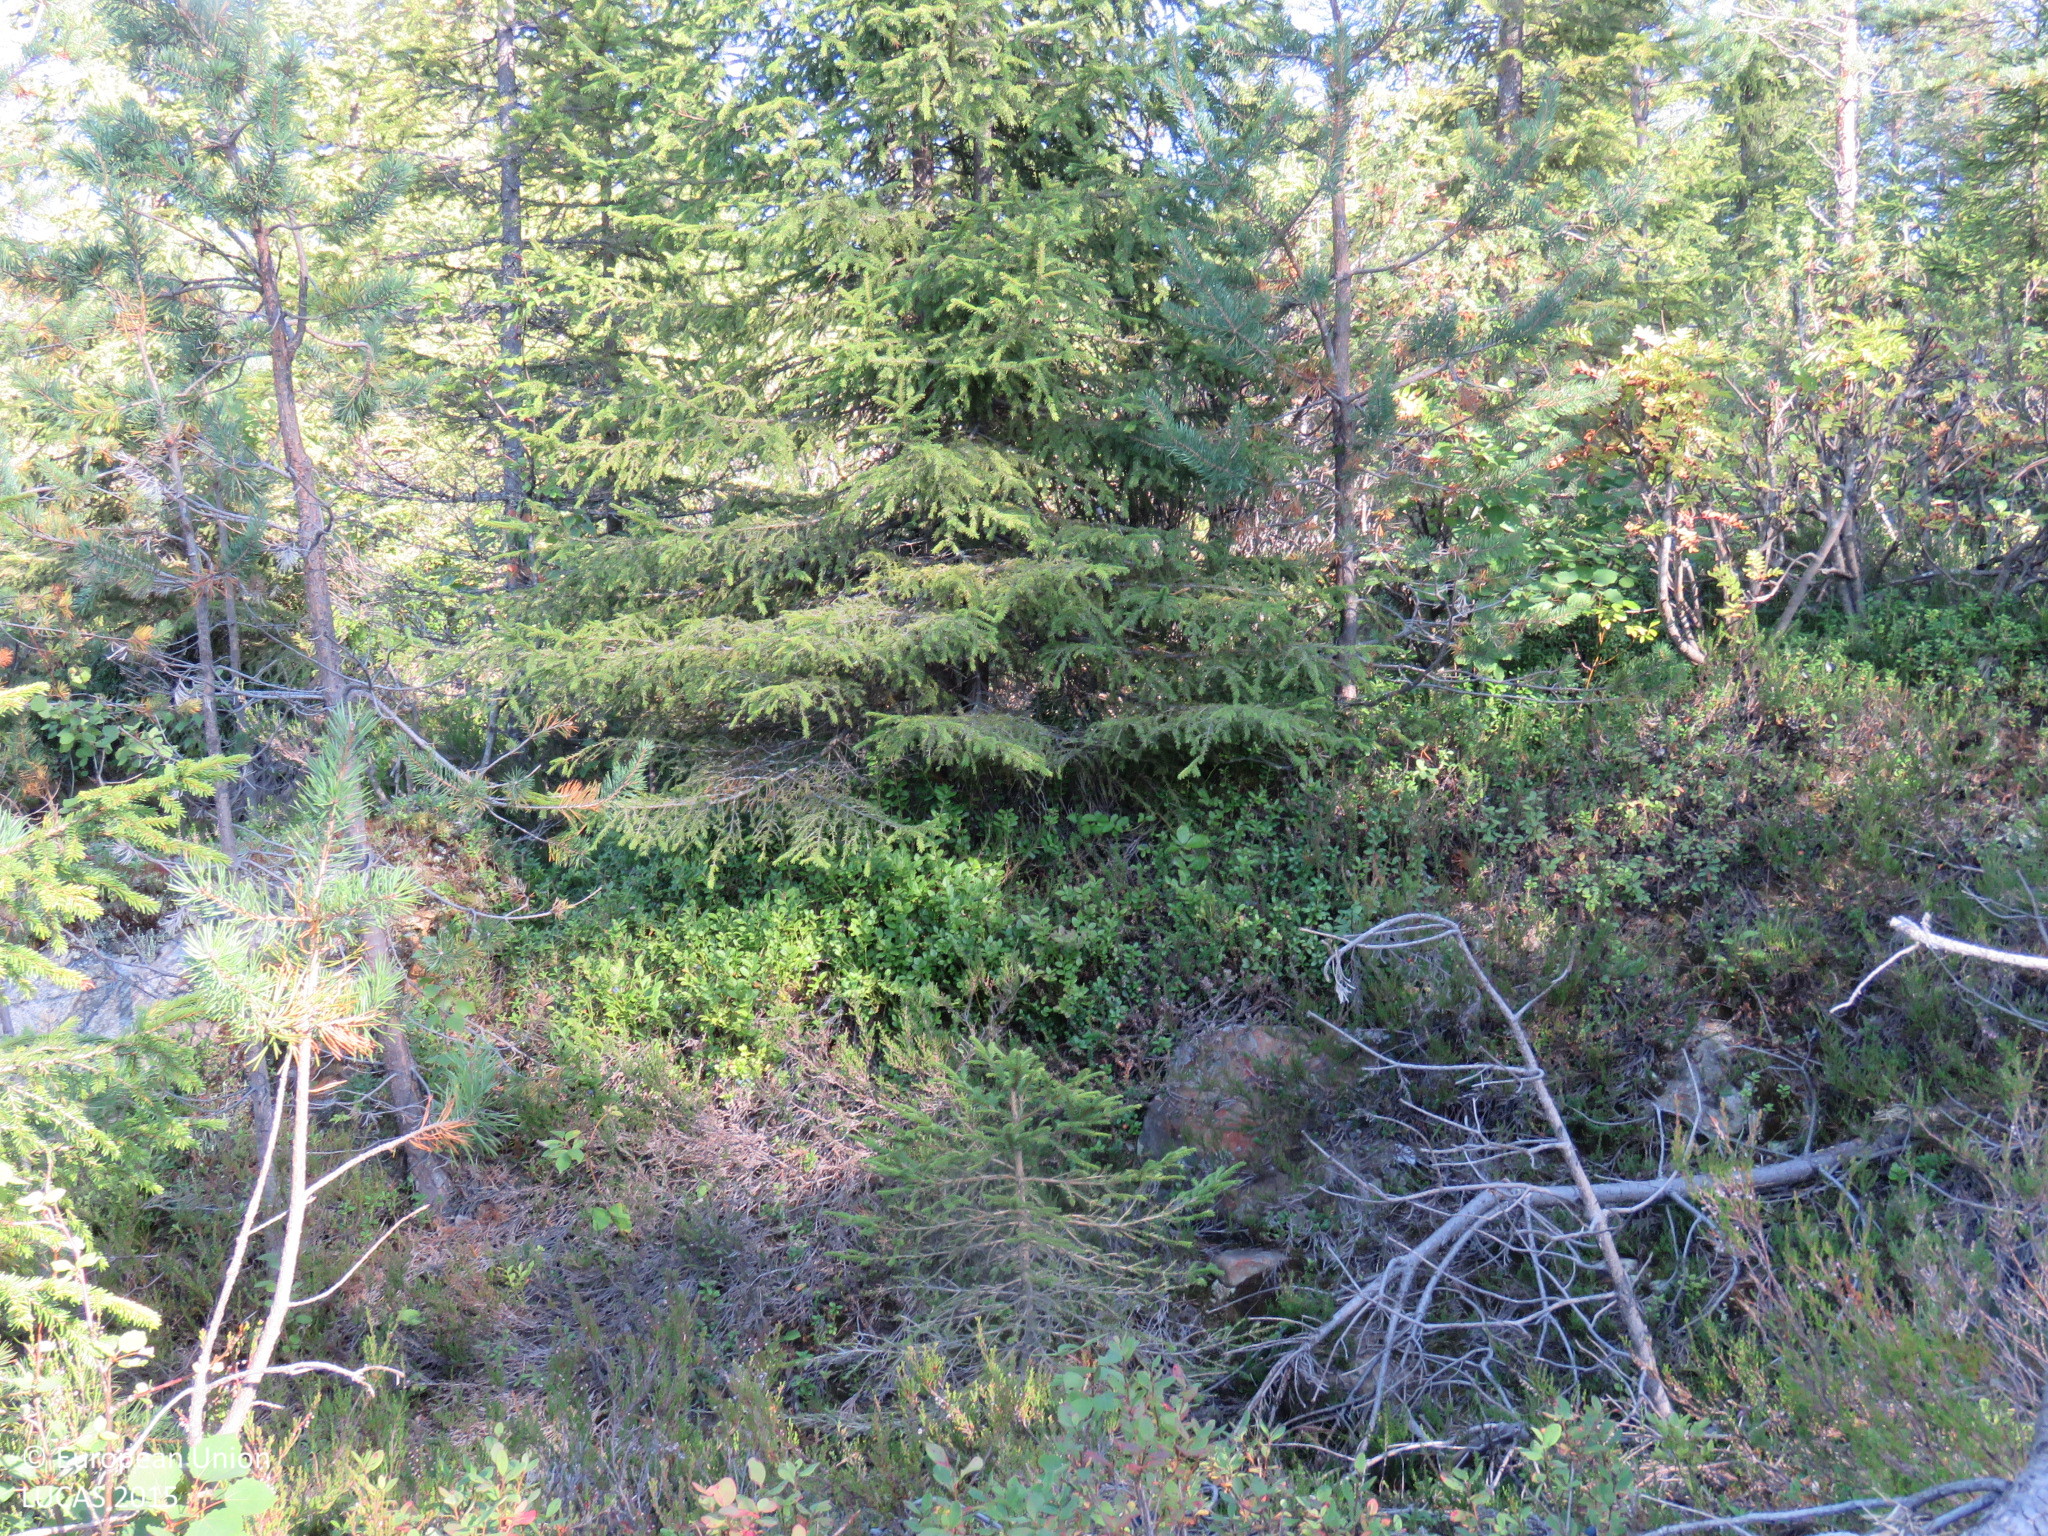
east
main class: Woodland
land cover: Spruce dominated coniferous woodland
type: boreal forest
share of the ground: > 75 %
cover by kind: coniferous forest trees 70 %, shrubs 25 %, broadleaved forest trees 5 %
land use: Forestry
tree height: > 5 m
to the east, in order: Spruce dominated coniferous woodland; Shrubland with sparse tree cover; Spruce dominated coniferous woodland; Shrubland with sparse tree cover; Electric lines; Shrubland with sparse tree cover; Spruce dominated coniferous woodland
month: September
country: FI
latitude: 65.5486
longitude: 27.5598
